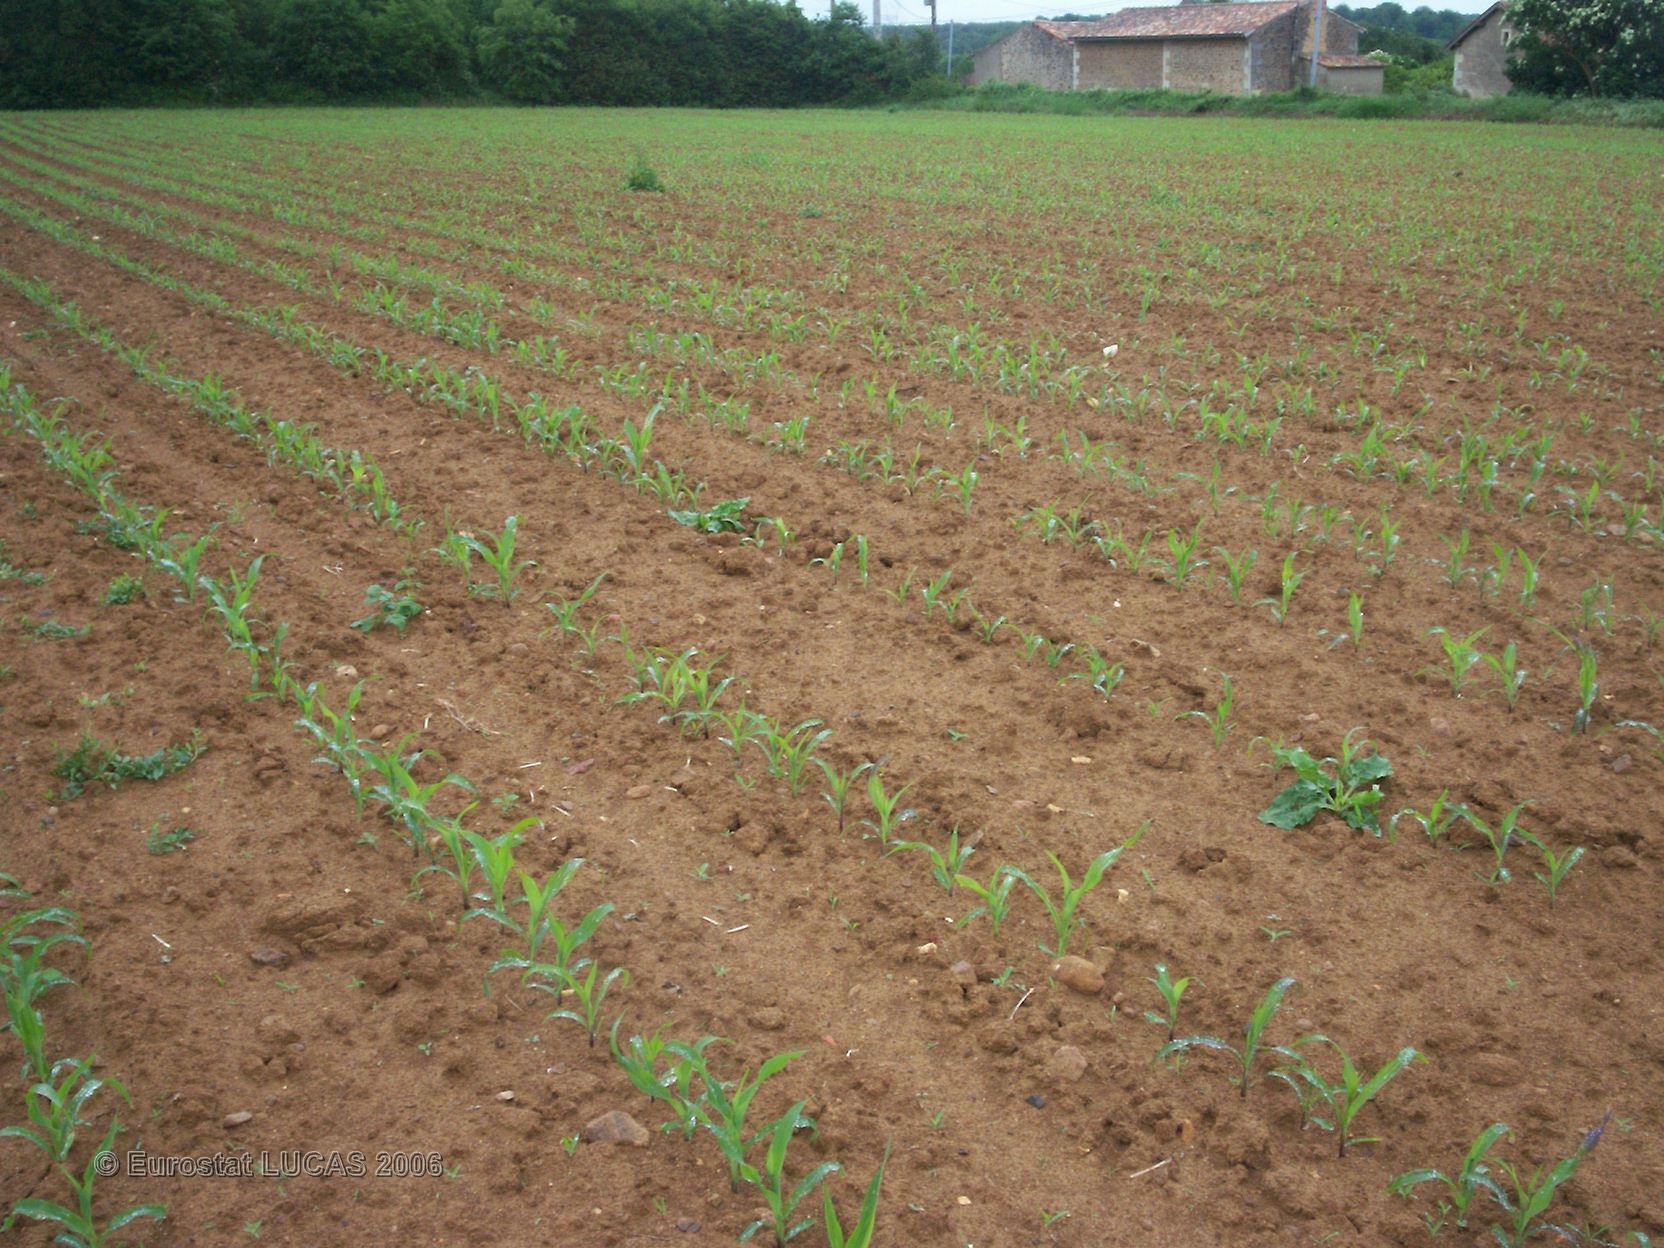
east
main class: Cropland
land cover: Maize
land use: Agriculture (excluding fallow land and kitchen gardens)
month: May
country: FR
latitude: 46.6845
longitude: 0.4501
